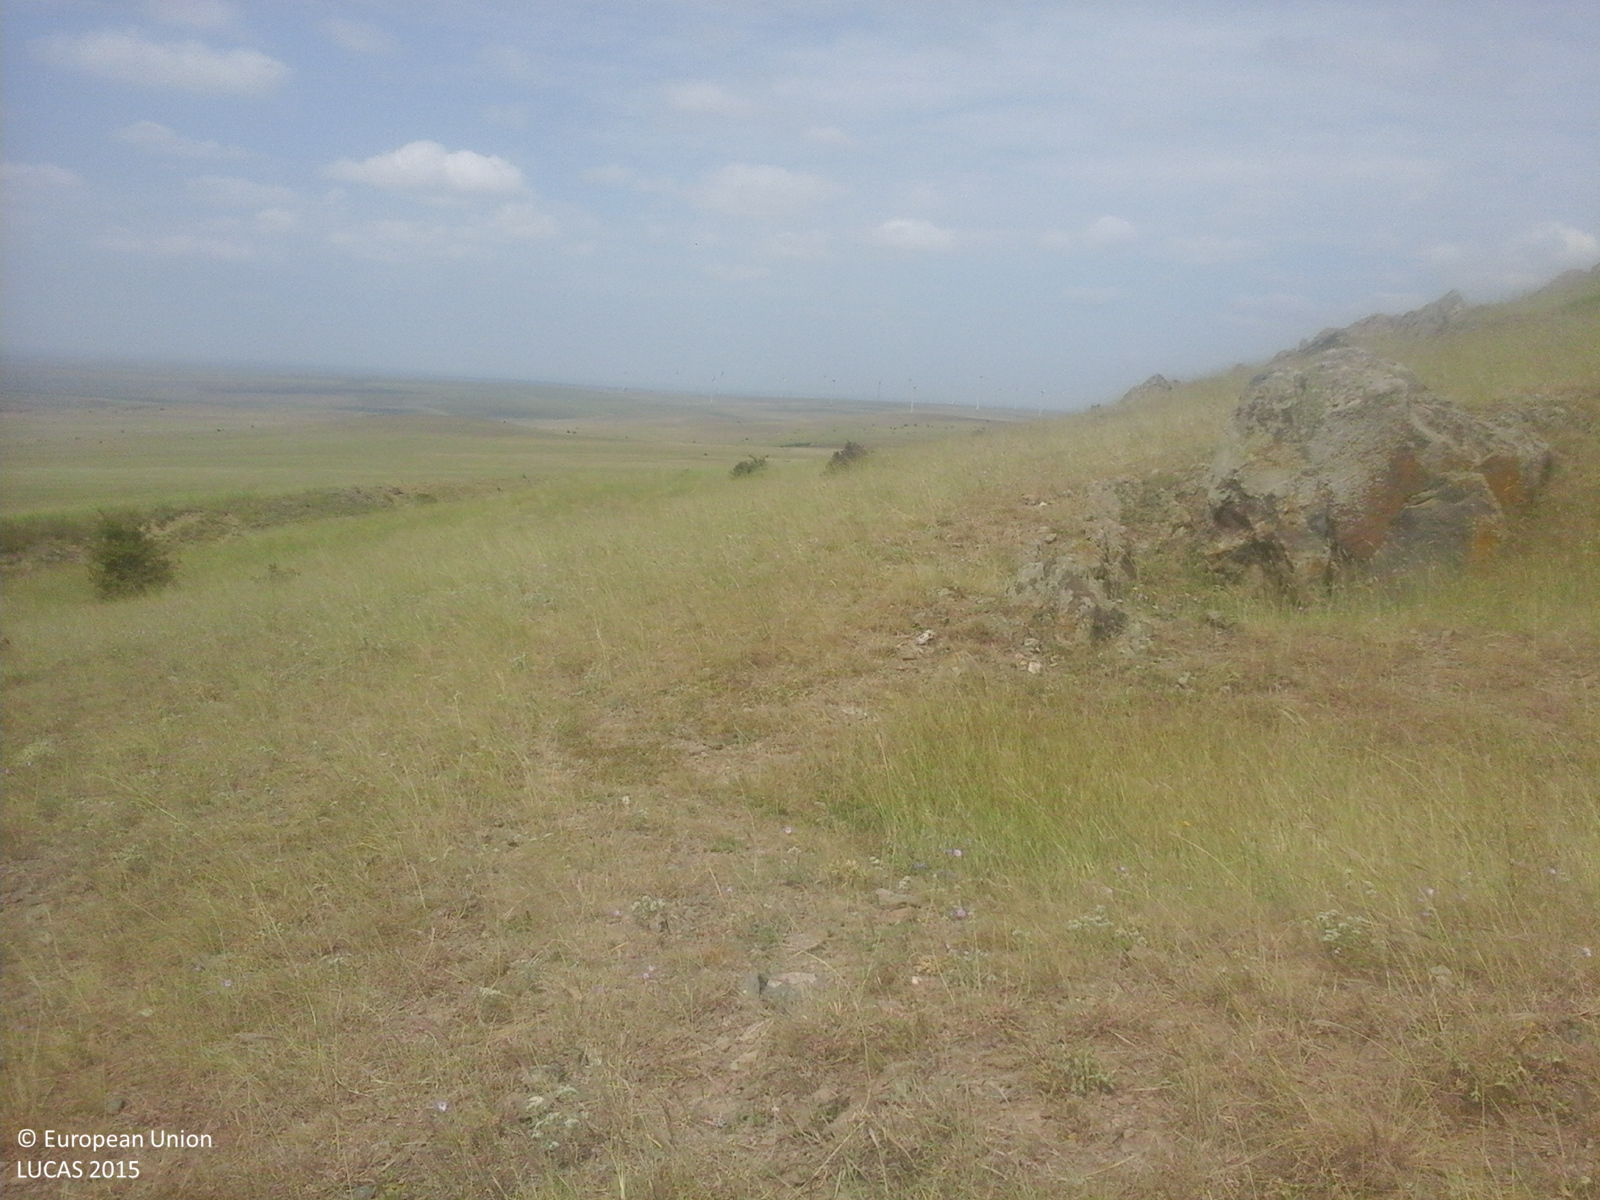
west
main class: Grassland
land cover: Grassland without tree/shrub cover
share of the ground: > 75 %
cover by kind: herbaceous plants 90 %, unconsolidated bare surface 10 %
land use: Agriculture (excluding fallow land and kitchen gardens)
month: August
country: RO
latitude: 44.7508
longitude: 28.3221
